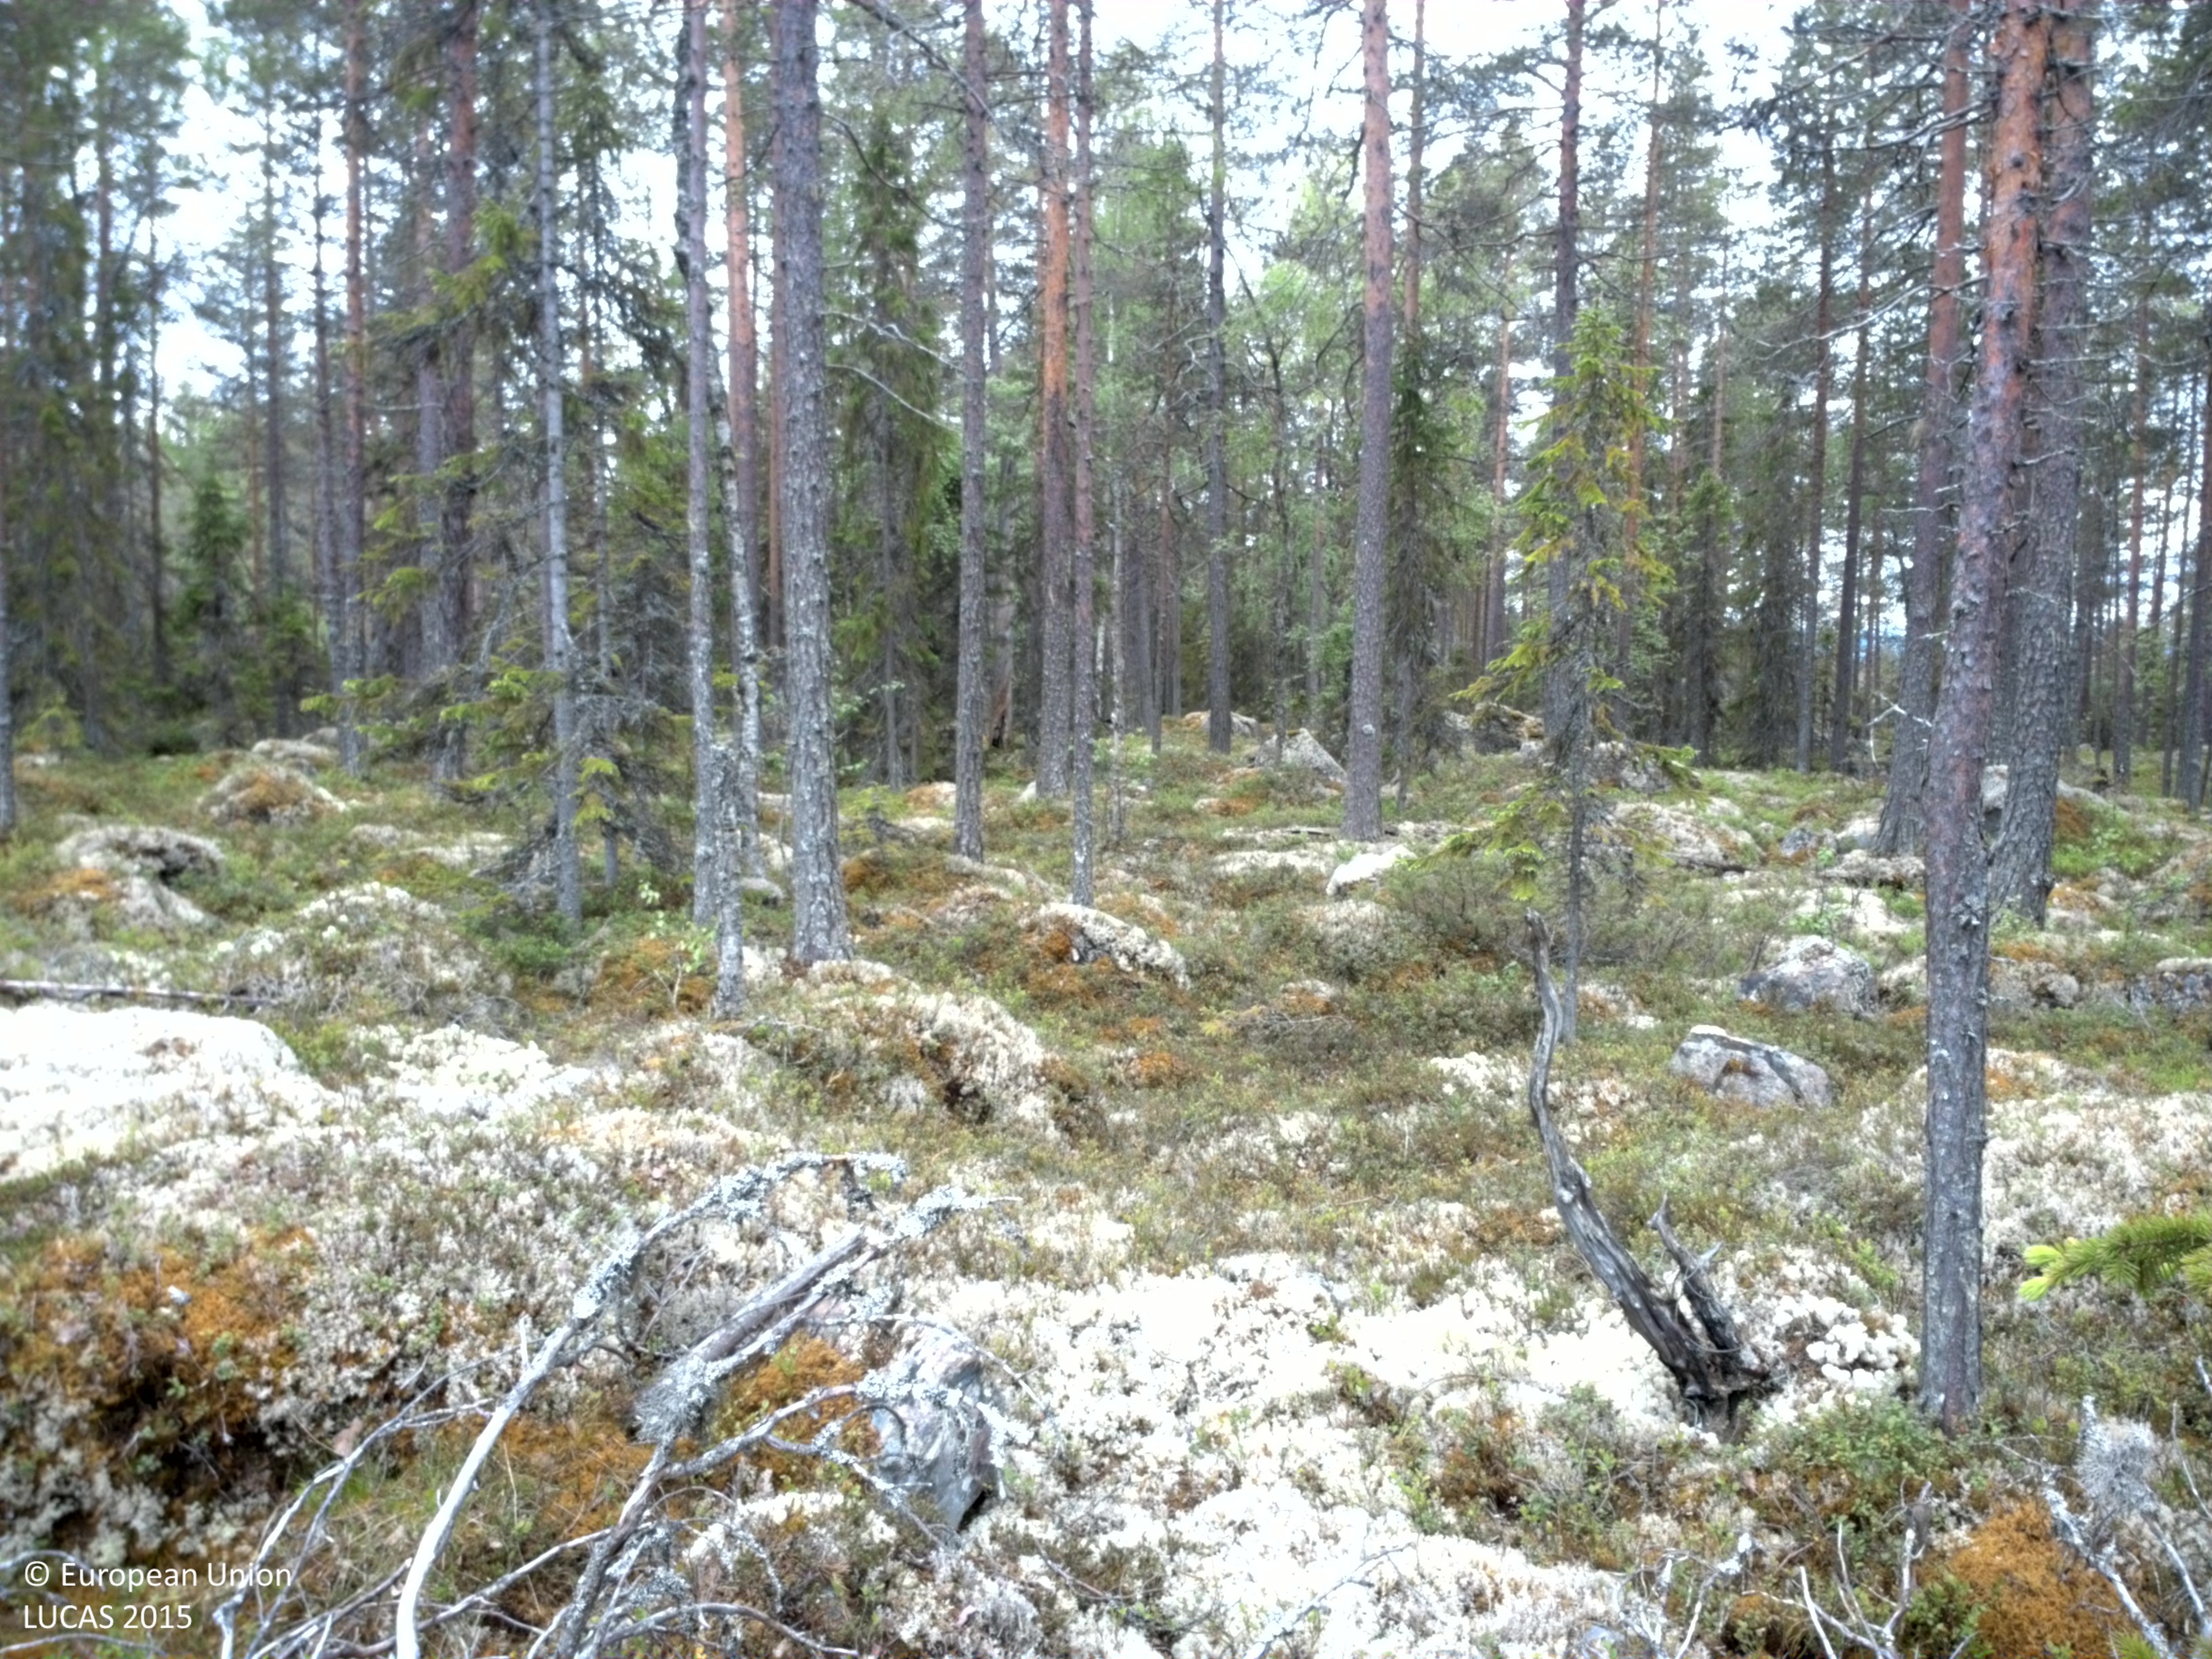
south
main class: Woodland
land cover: Pine dominated coniferous woodland
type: boreal forest
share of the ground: 50 - 75 %
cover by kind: coniferous forest trees 55 %, lichens and mosses 25 %, herbaceous plants 15 %, consolidated bare surface 5 %
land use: Forestry
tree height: > 5 m
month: June
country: SE
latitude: 61.4019
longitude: 13.3776
